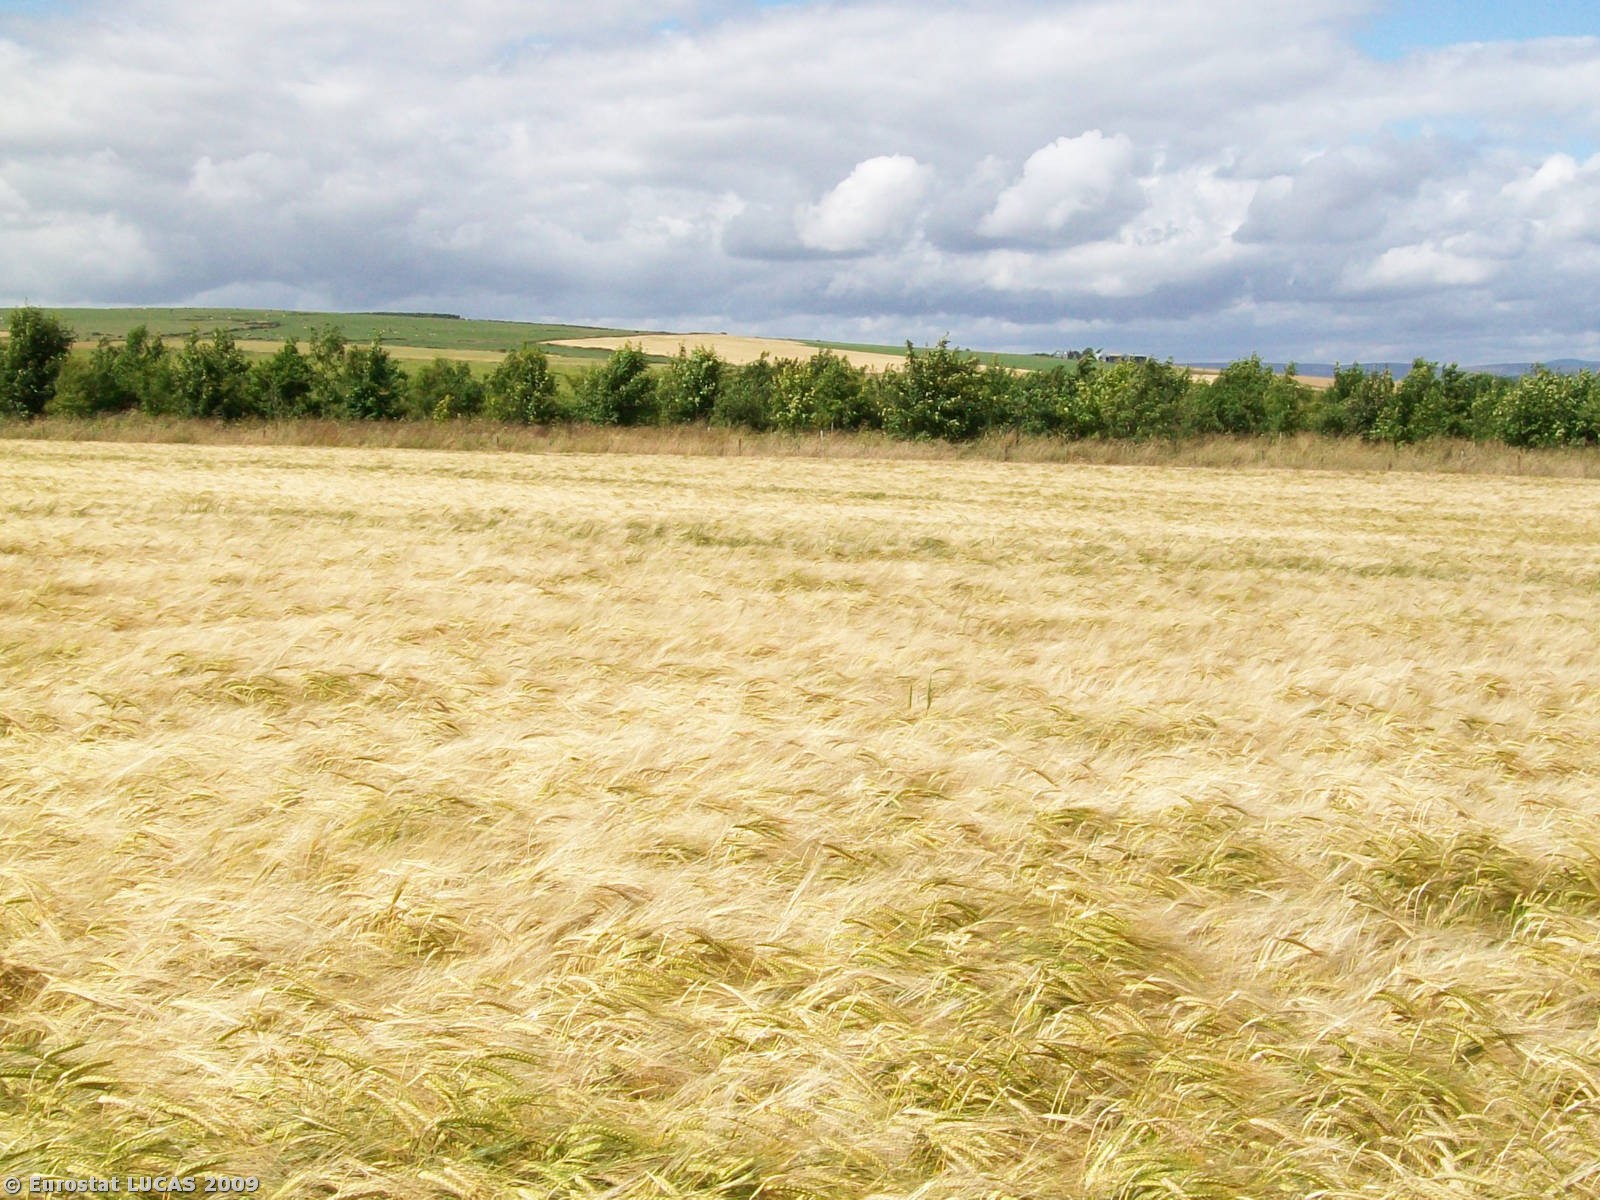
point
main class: Cropland
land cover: Barley
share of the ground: > 75 %
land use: Agriculture (excluding fallow land and kitchen gardens)
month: August
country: GB
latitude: 56.8438
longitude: -2.3655
